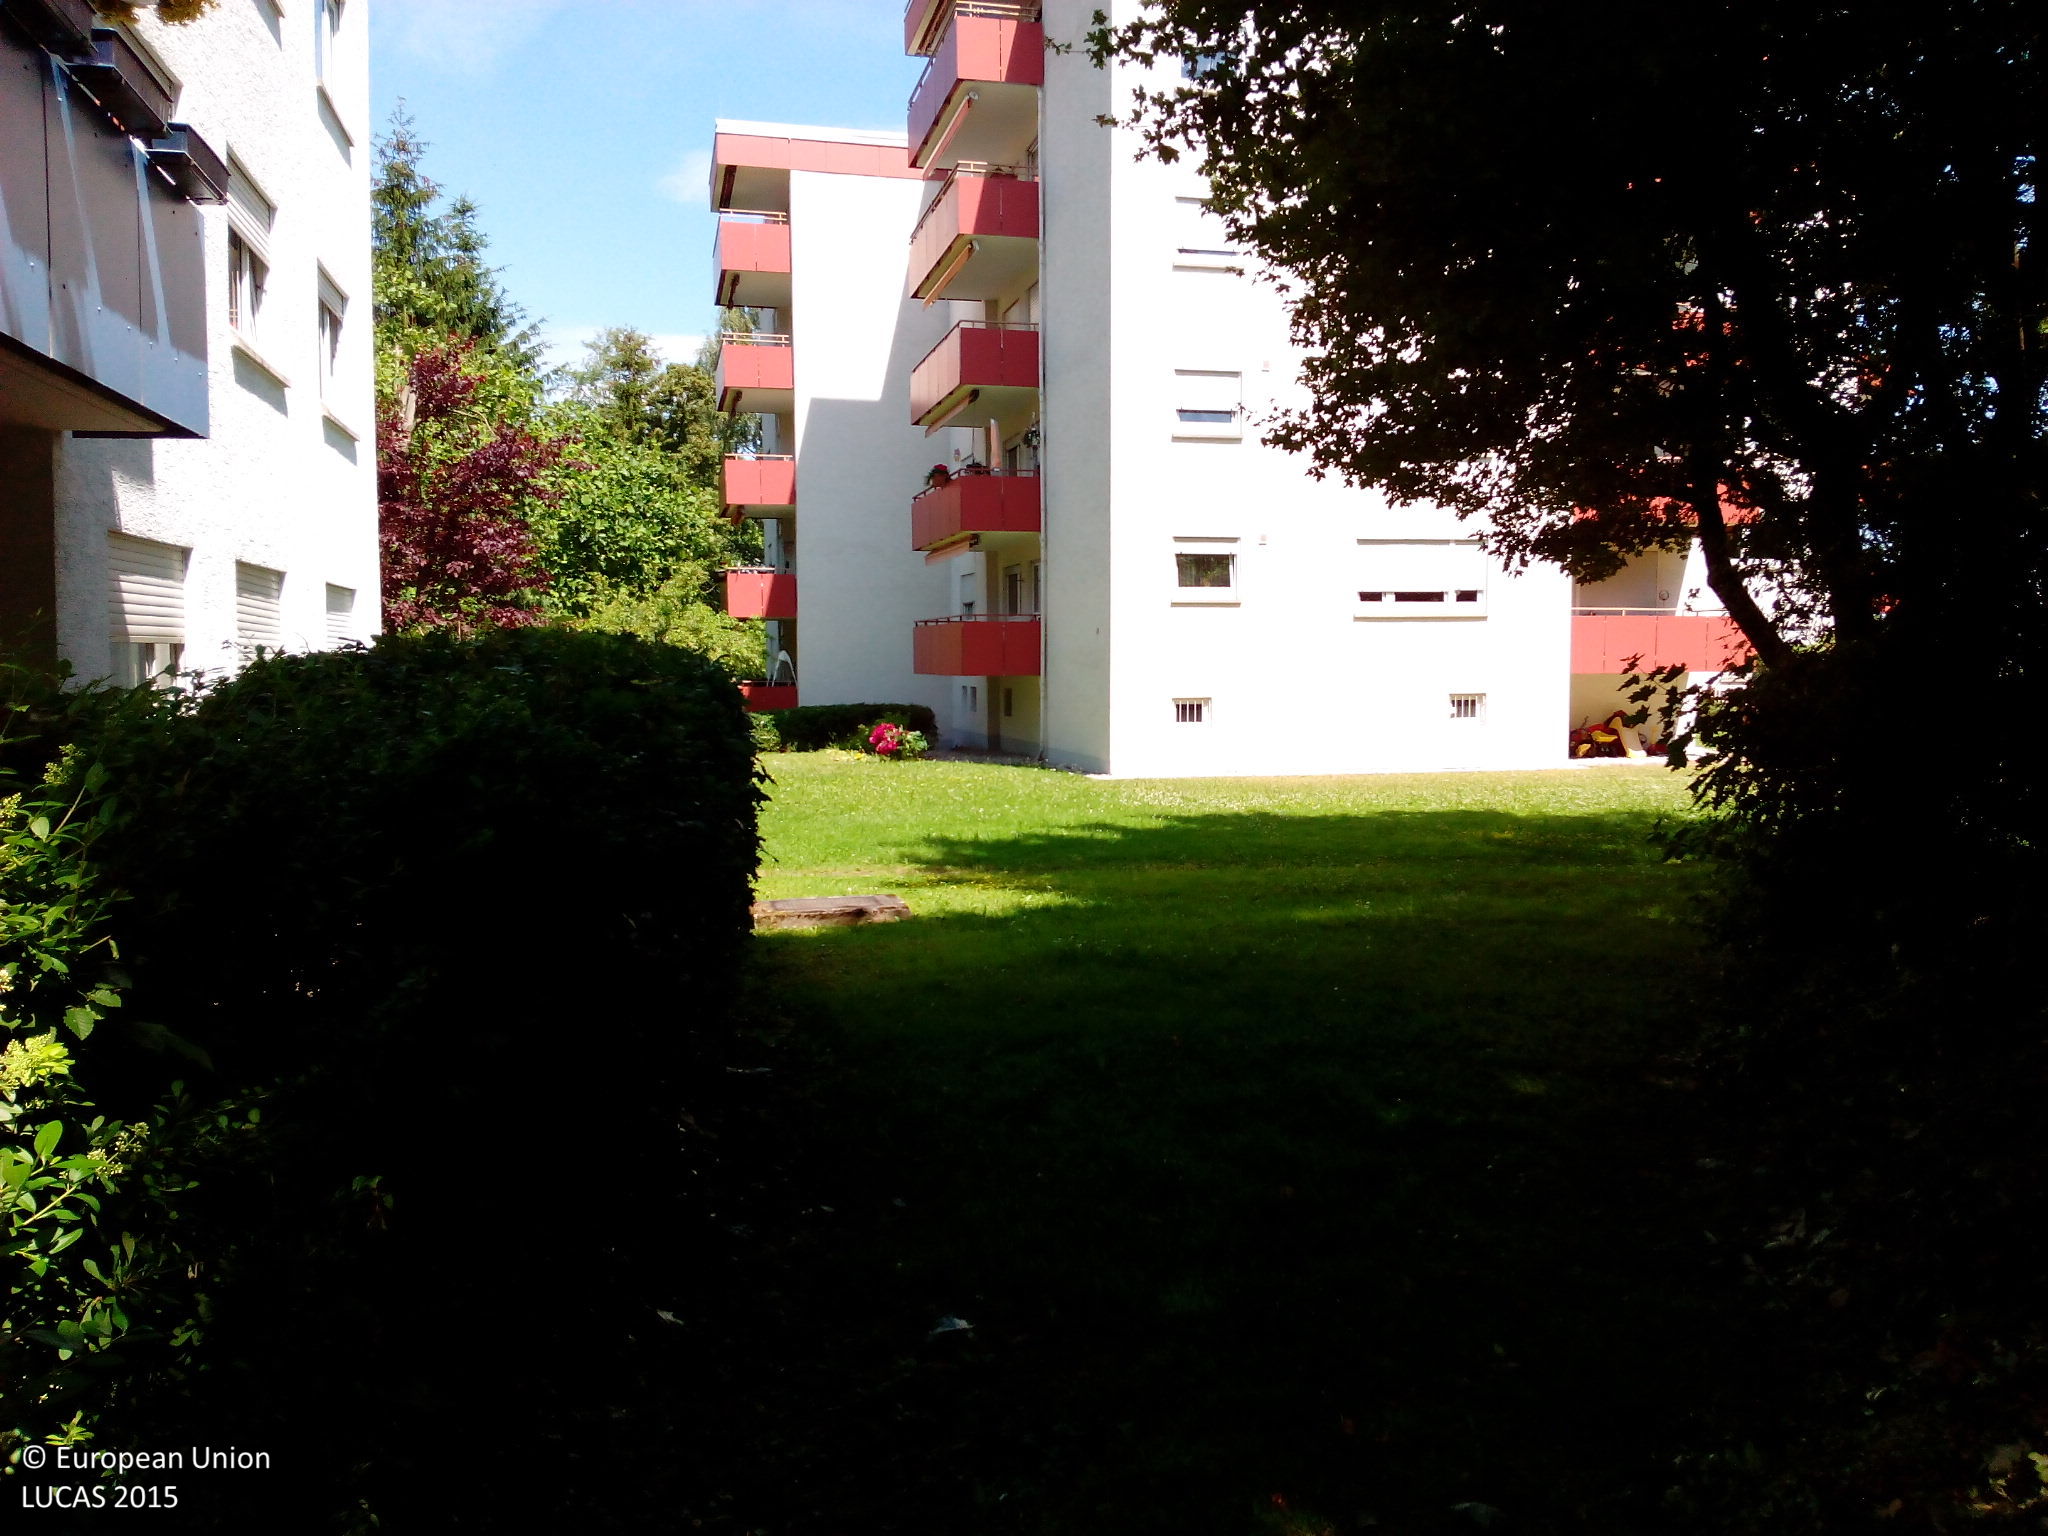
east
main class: Grassland
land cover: Grassland without tree/shrub cover
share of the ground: > 75 %
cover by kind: herbaceous plants 100 %
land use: Residential
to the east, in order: Grassland without tree/shrub cover; Artificial constructions in urban areas; Grass margins; Common wheat; Maize; Other fresh vegetables; Maize
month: June
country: DE
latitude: 48.9409
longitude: 9.2767
